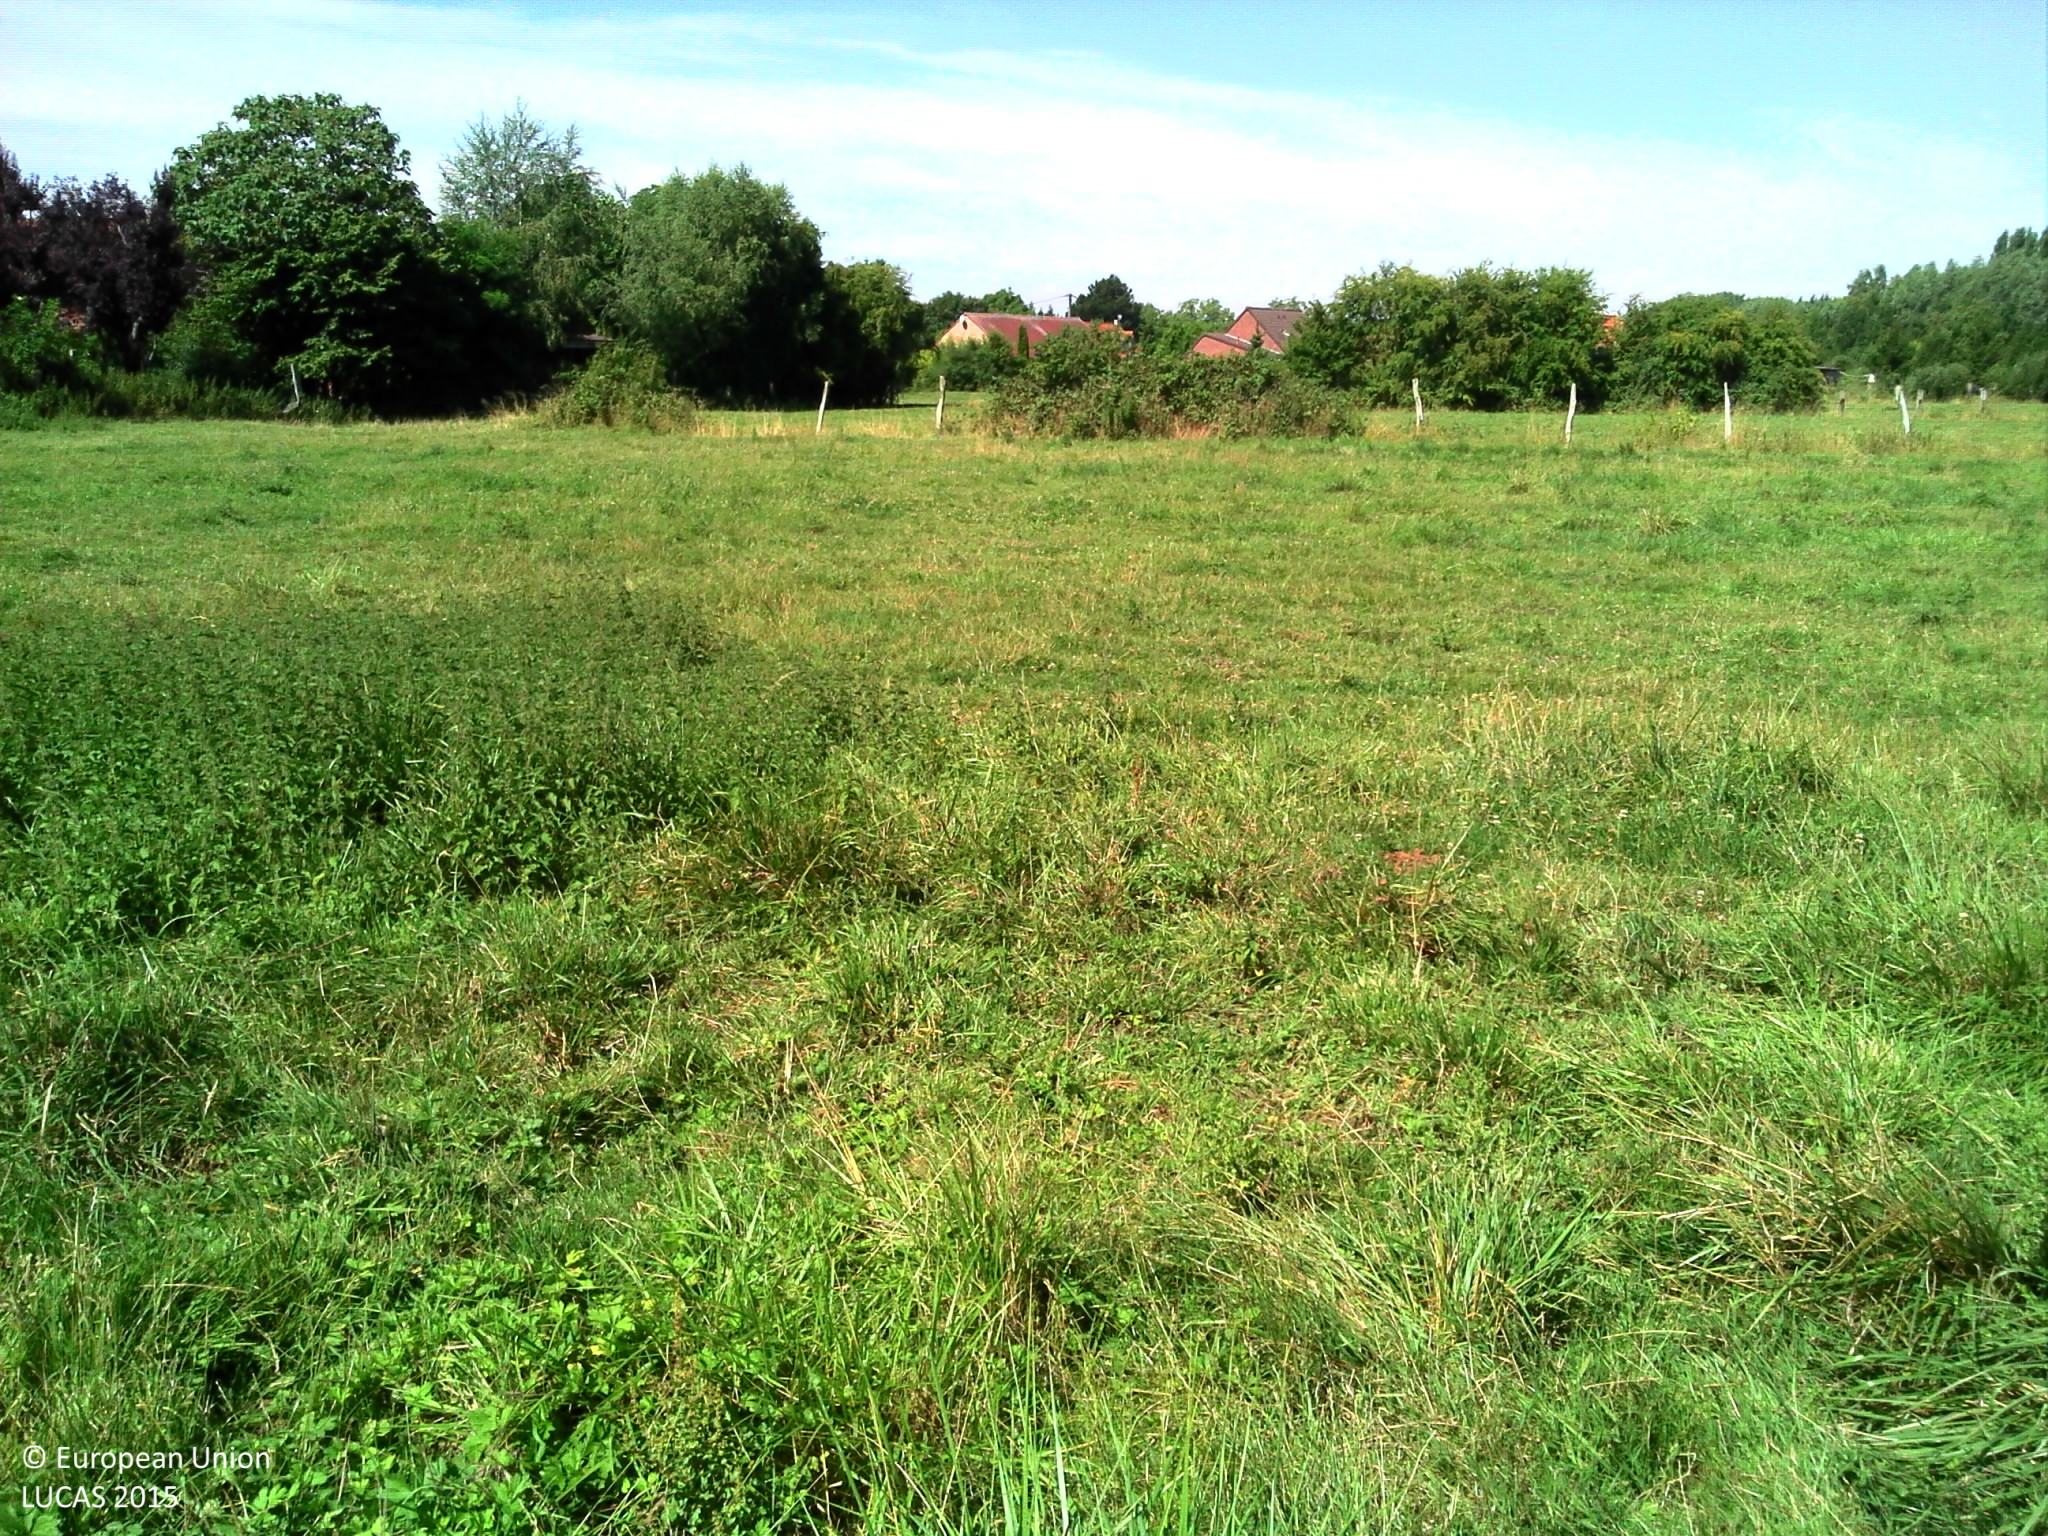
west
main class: Grassland
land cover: Grassland without tree/shrub cover
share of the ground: > 75 %
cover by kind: herbaceous plants 95 %, lichens and mosses 5 %
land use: Agriculture (excluding fallow land and kitchen gardens)
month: August
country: FR
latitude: 50.3586
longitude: 3.1736
